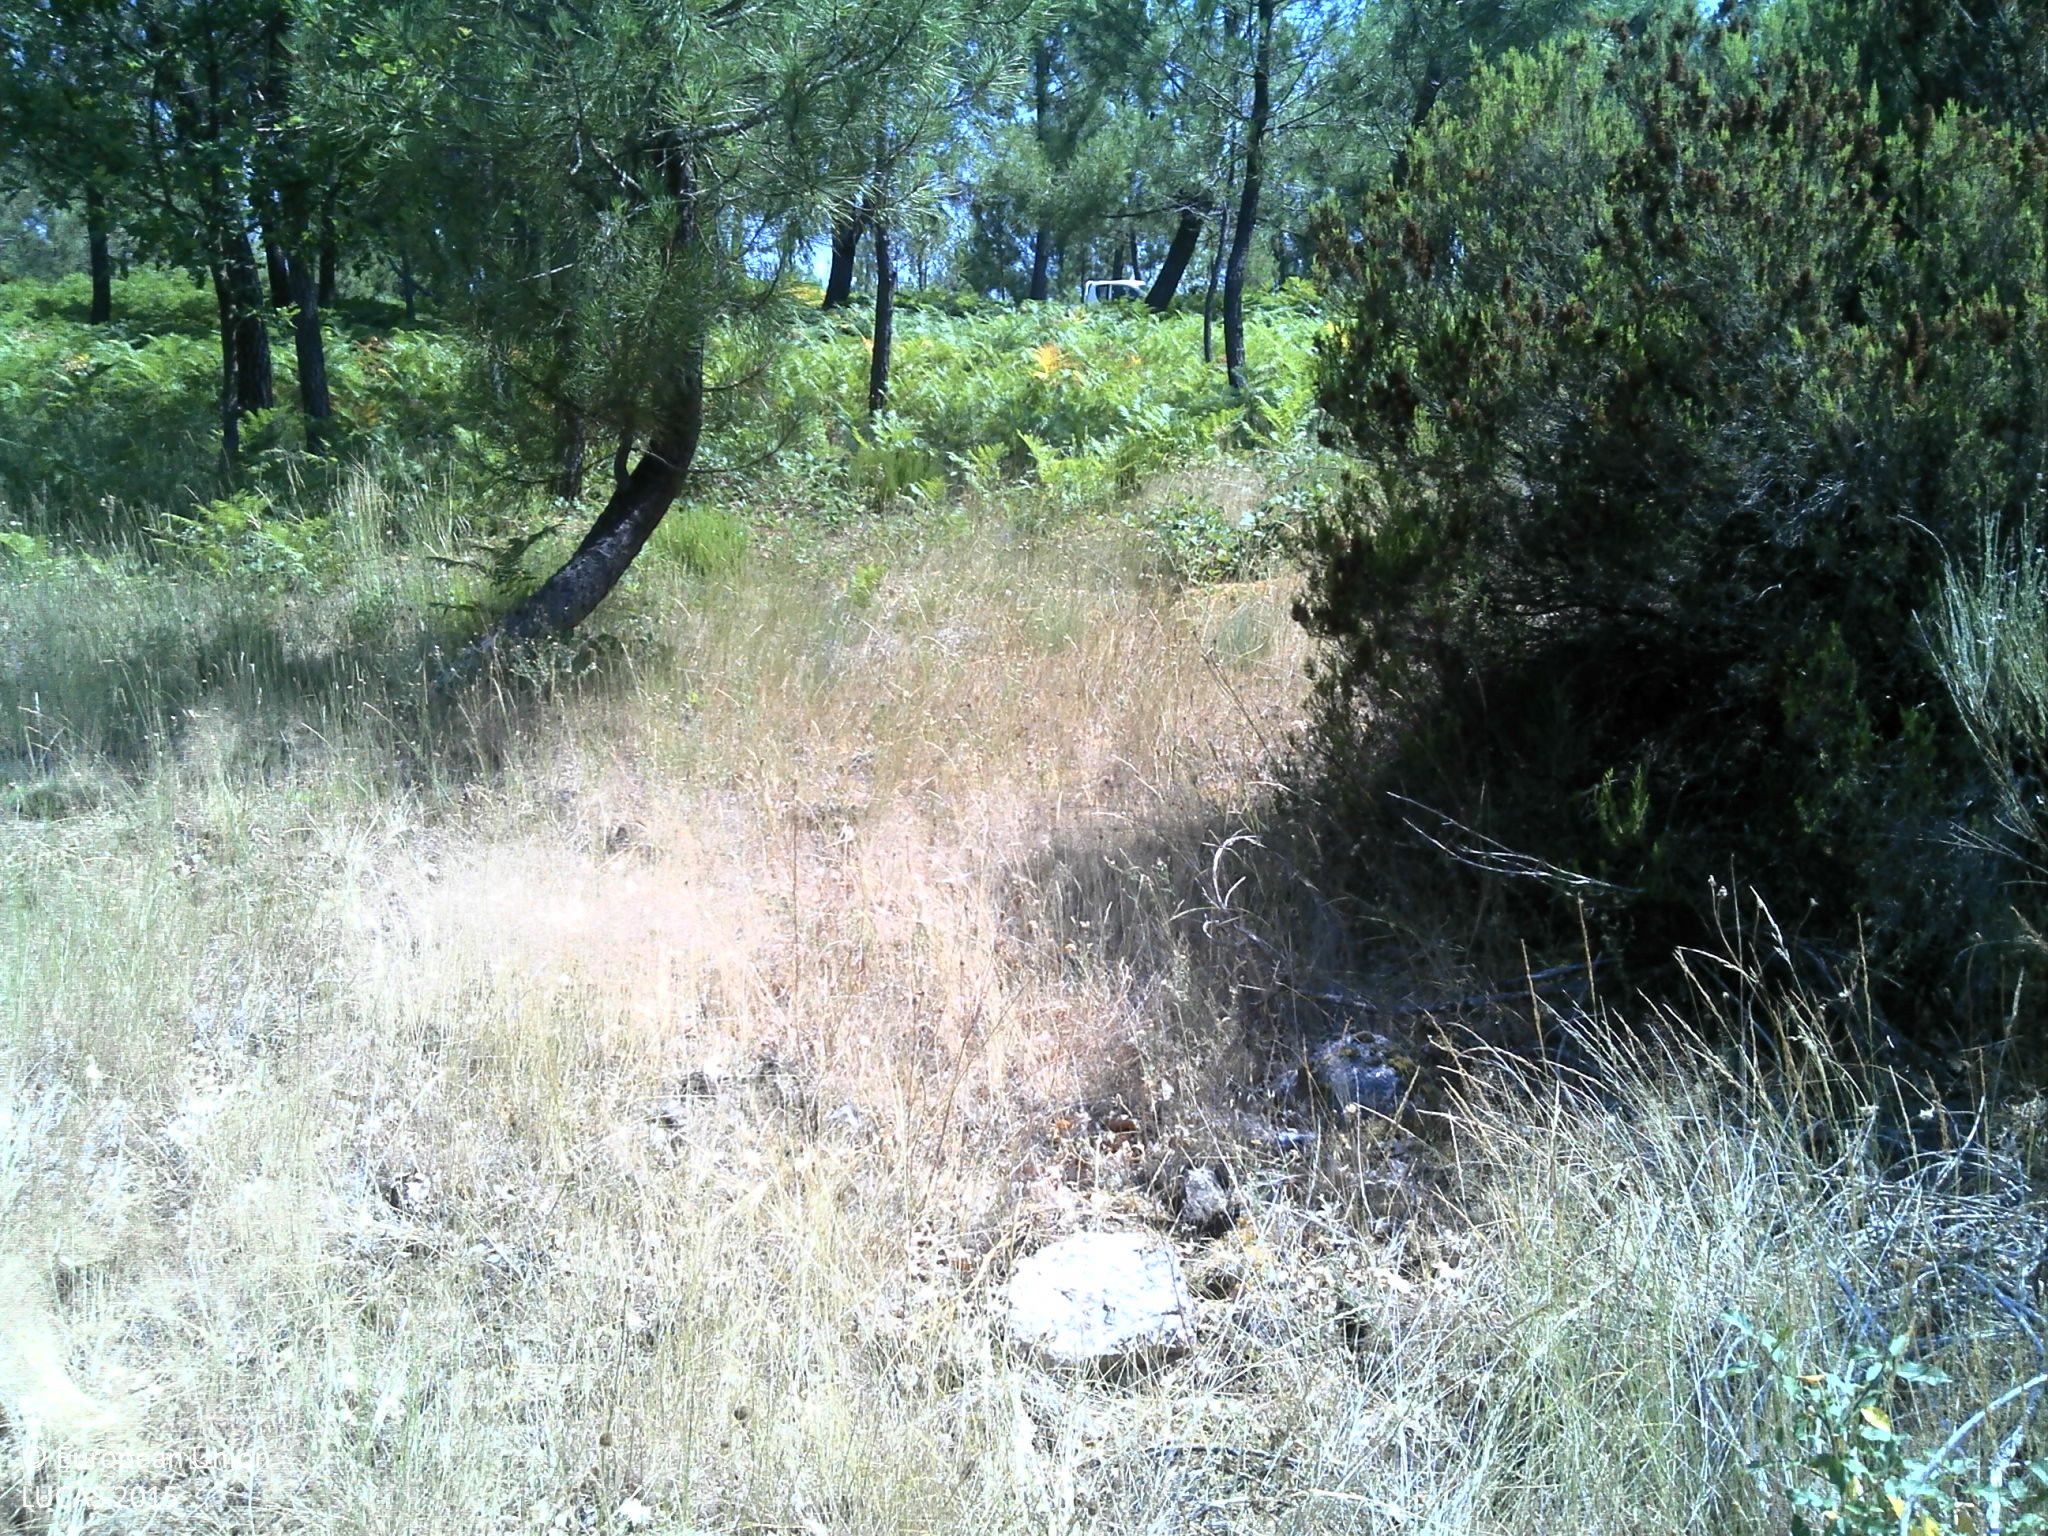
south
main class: Shrubland
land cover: Shrubland with sparse tree cover
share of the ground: 50 - 75 %
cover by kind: shrubs 50 %, herbaceous plants 20 %, consolidated bare surface 20 %, broadleaved forest trees 5 %, unconsolidated bare surface 5 %
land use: Semi-natural and natural areas not in use
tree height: > 5 m
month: July
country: PT
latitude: 40.8246
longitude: -7.5841
